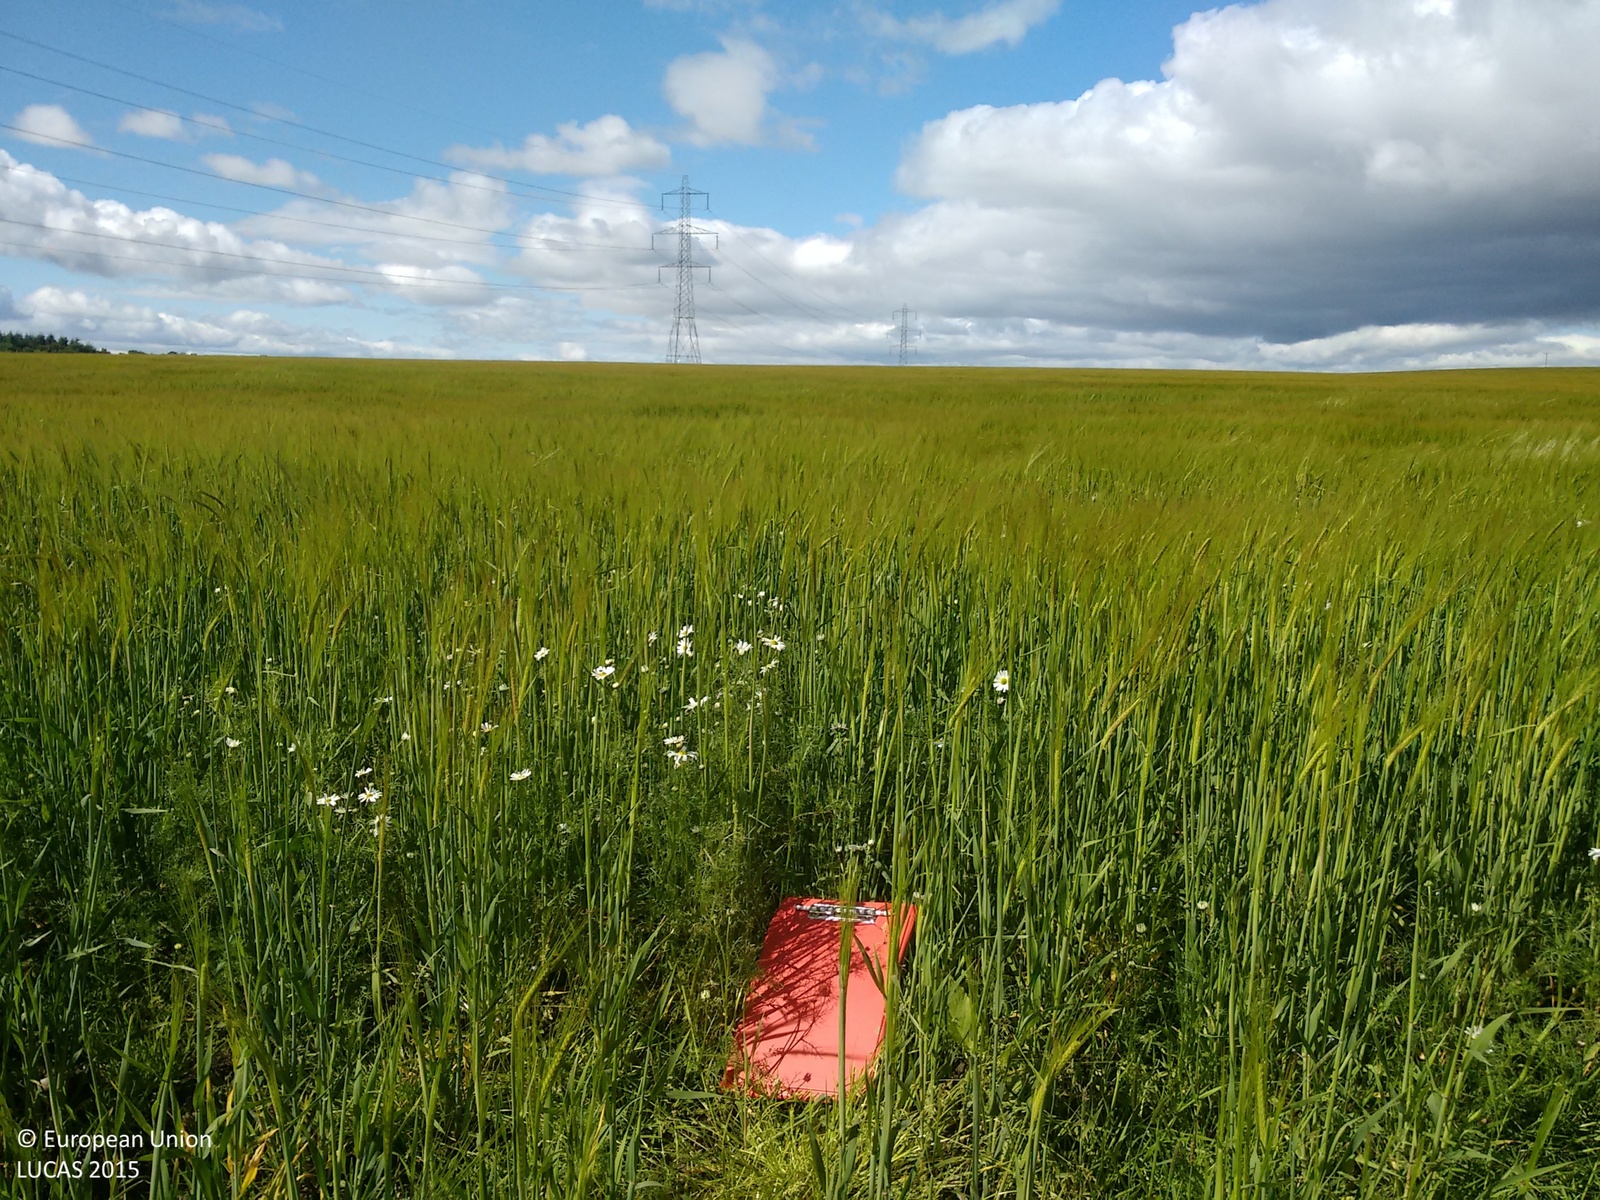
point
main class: Cropland
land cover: Barley
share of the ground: > 75 %
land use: Agriculture (excluding fallow land and kitchen gardens)
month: July
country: GB
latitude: 57.4849
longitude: -1.9373
